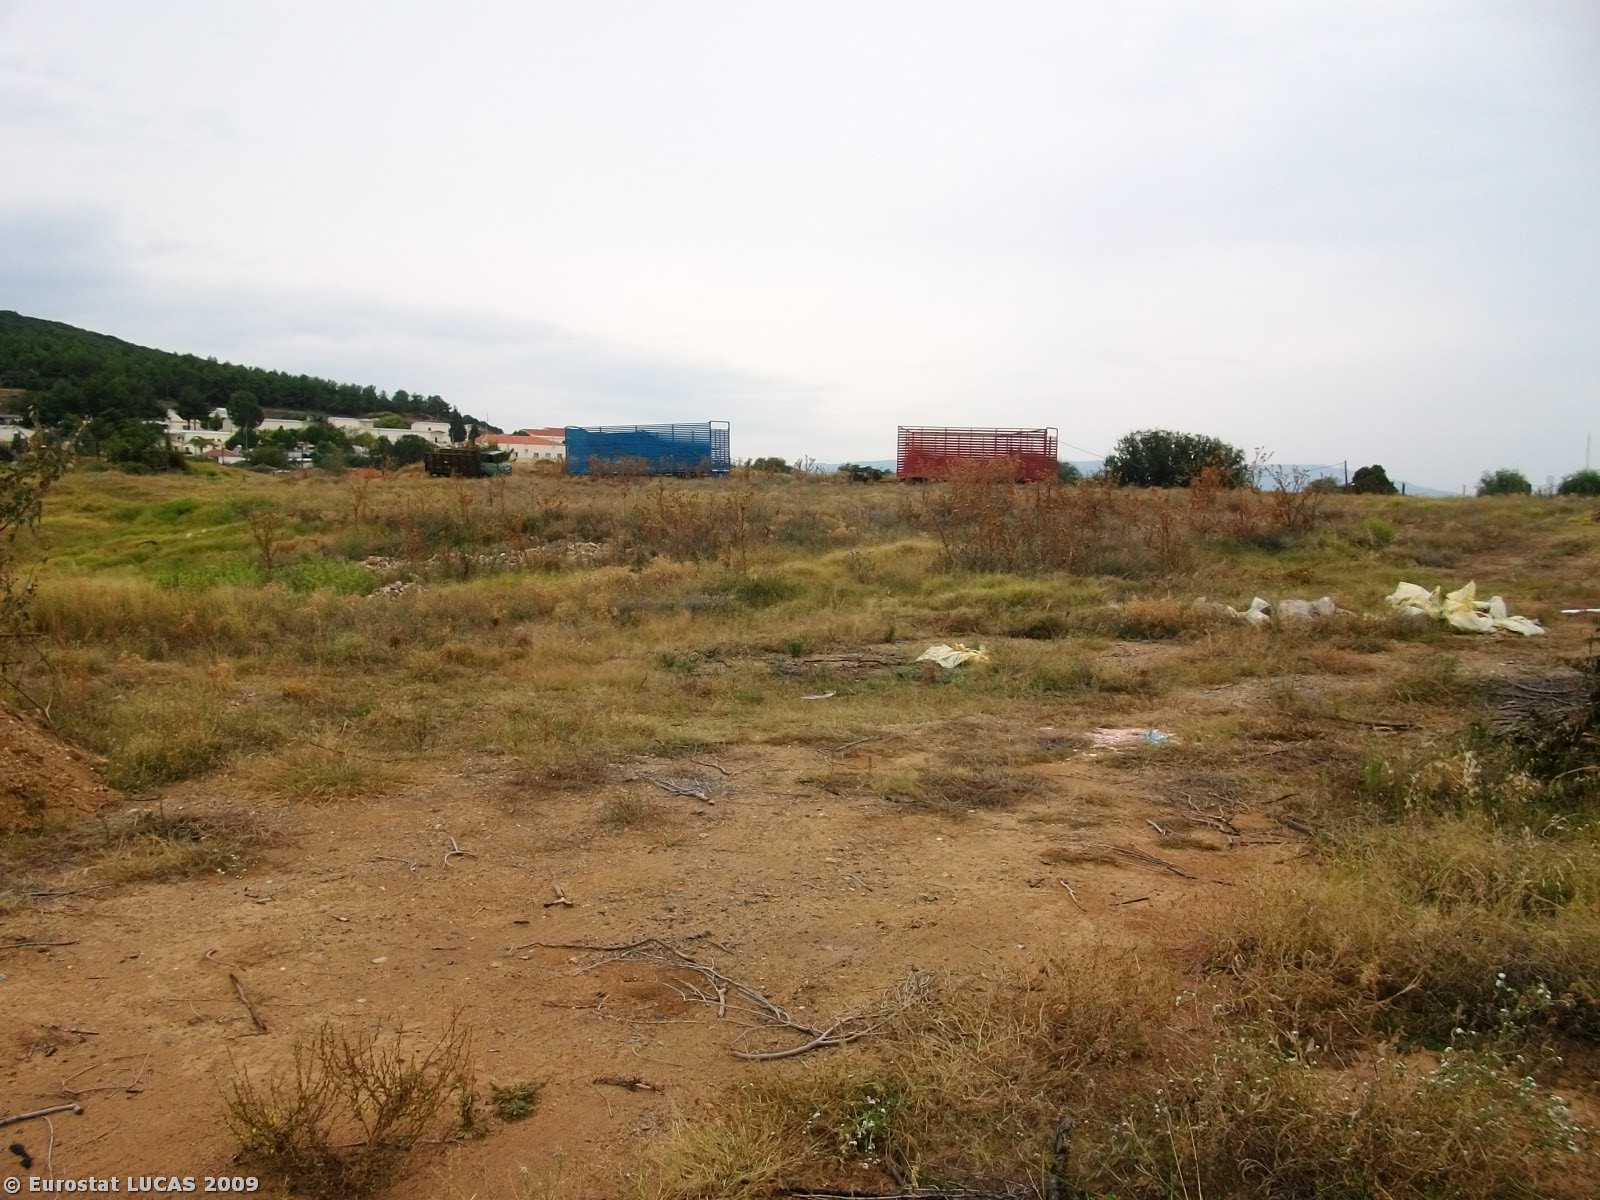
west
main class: Grassland
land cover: Grassland without tree/shrub cover
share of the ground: 50 - 75 %
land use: Agriculture (excluding fallow land and kitchen gardens)
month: September
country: GR
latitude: 40.8957
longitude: 23.5614
